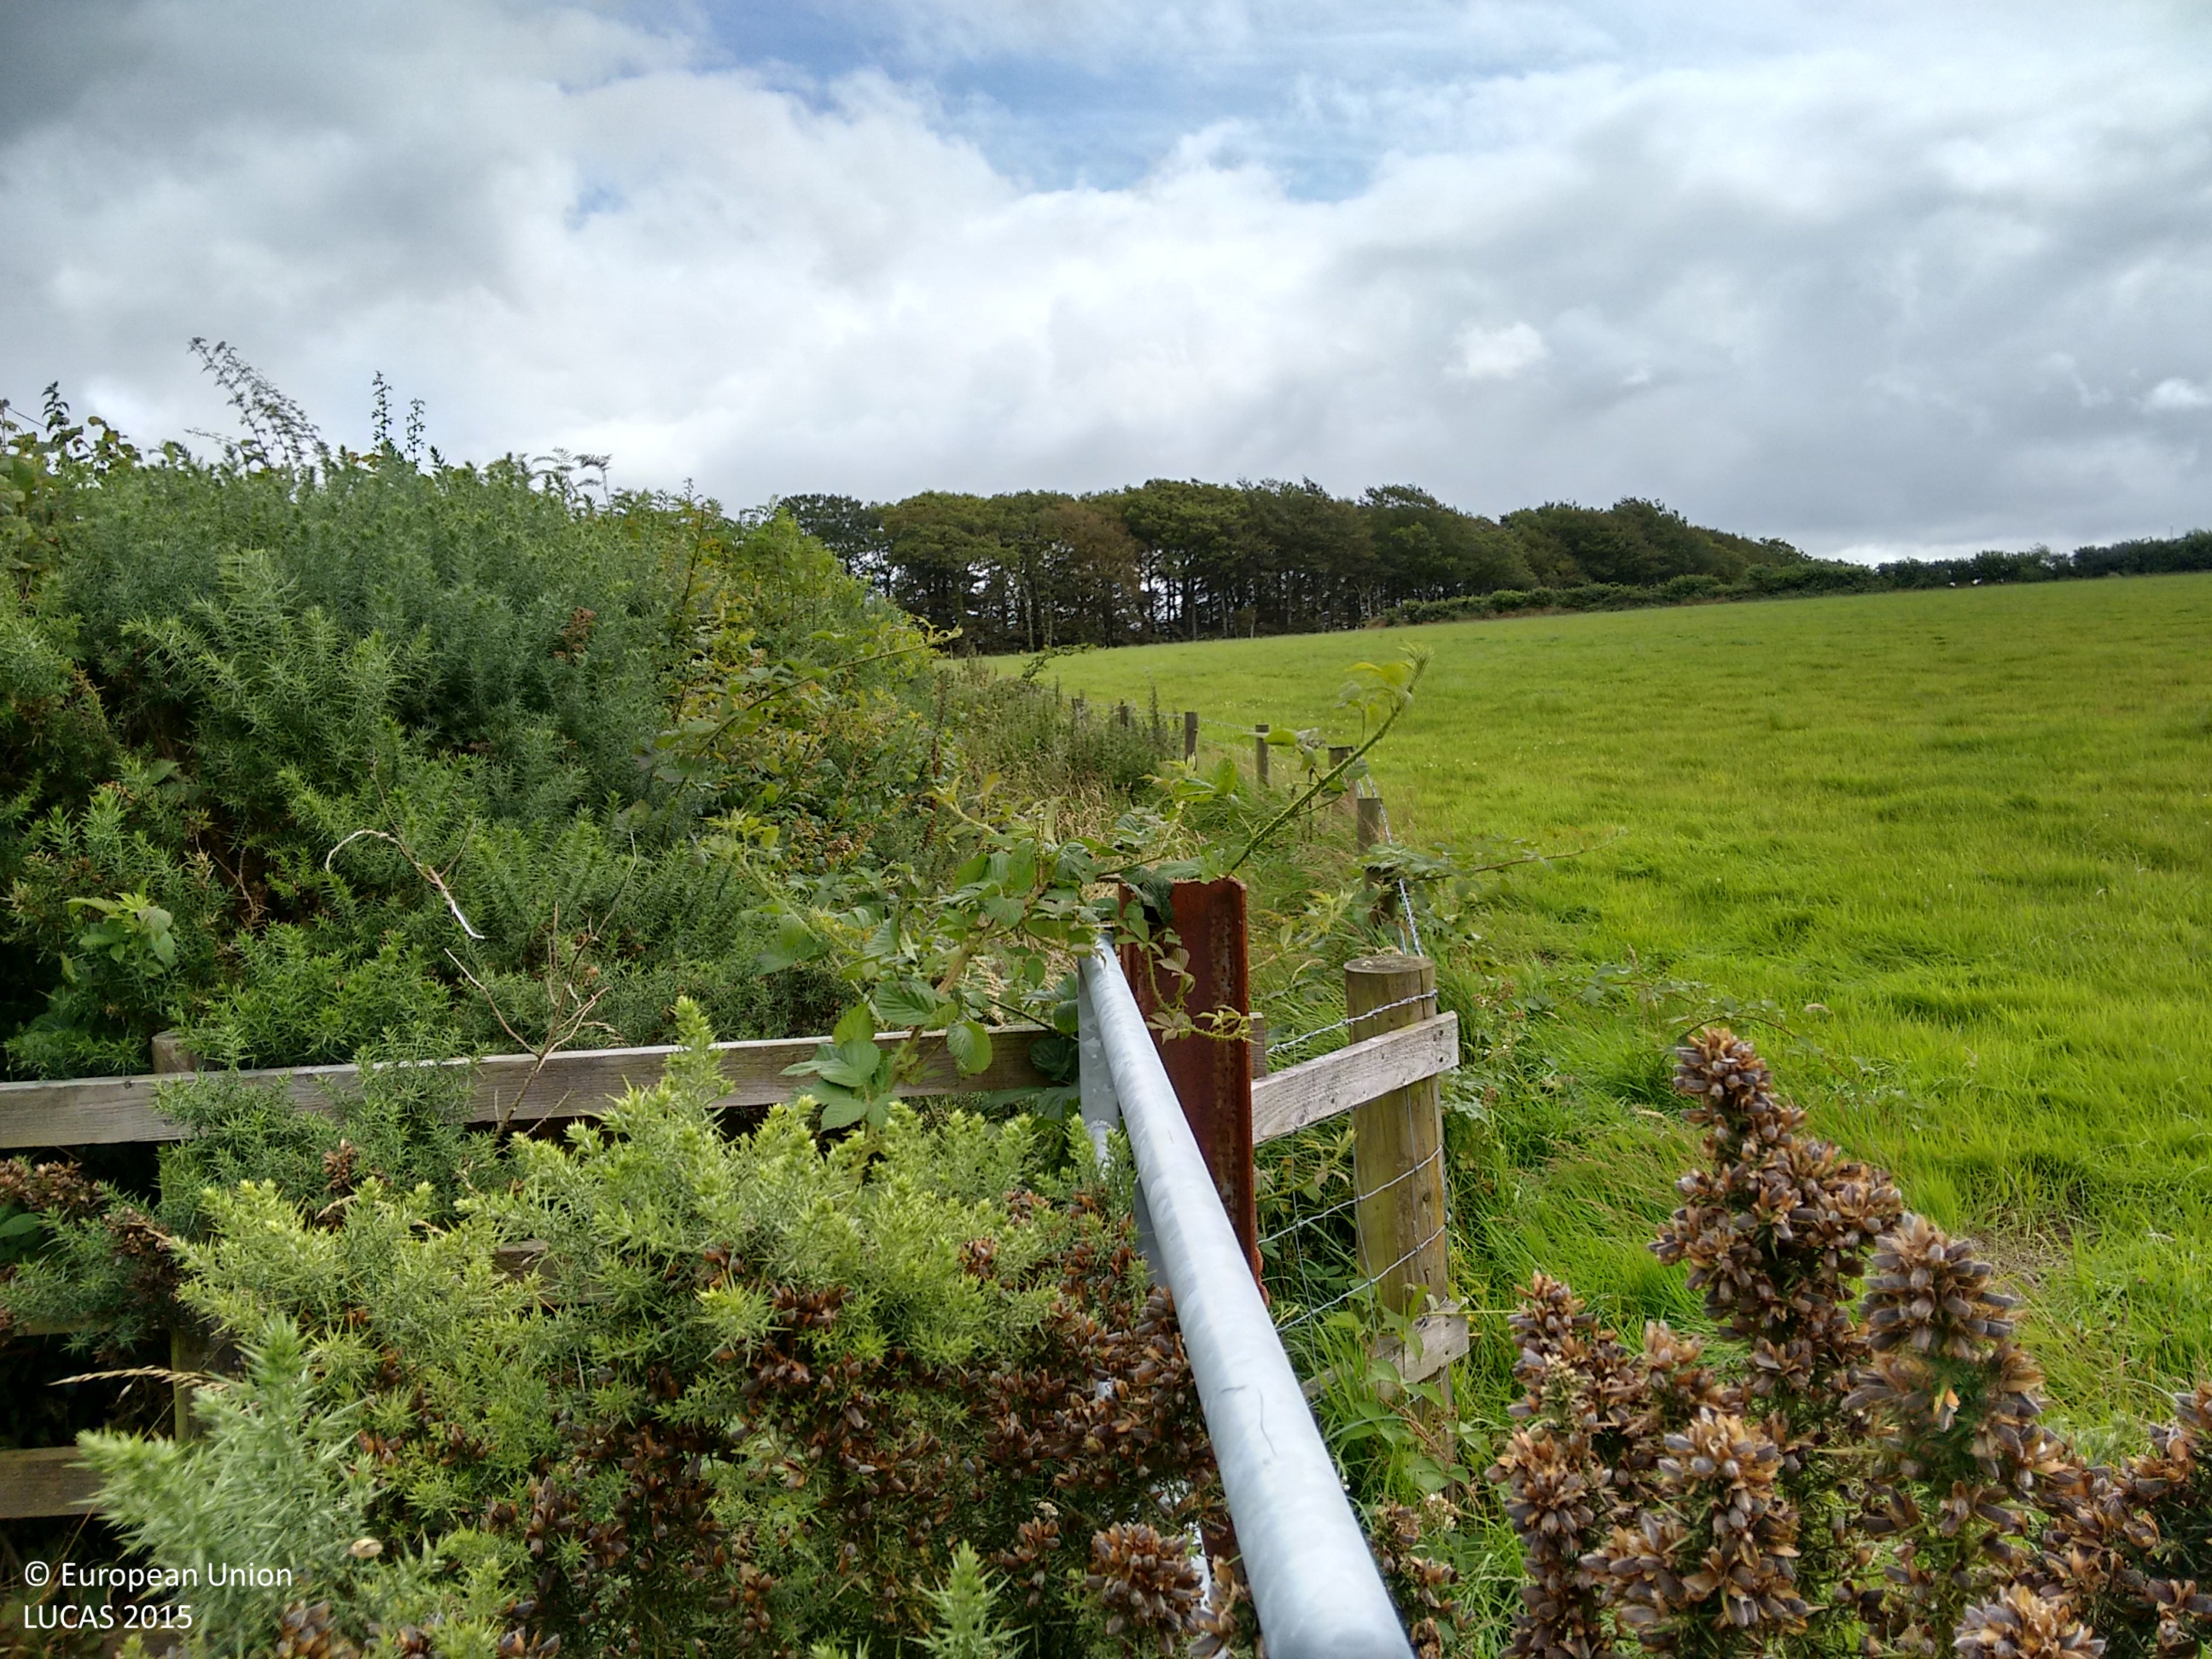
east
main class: Grassland
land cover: Grassland without tree/shrub cover
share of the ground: > 75 %
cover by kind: herbaceous plants 100 %
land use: Agriculture (excluding fallow land and kitchen gardens)
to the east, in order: Grassland without tree/shrub cover; Fences; Shrubland without tree cover; Fences; Broadleaved woodland; Fences; Grassland without tree/shrub cover
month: August
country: GB
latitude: 51.8403
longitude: -4.1029
